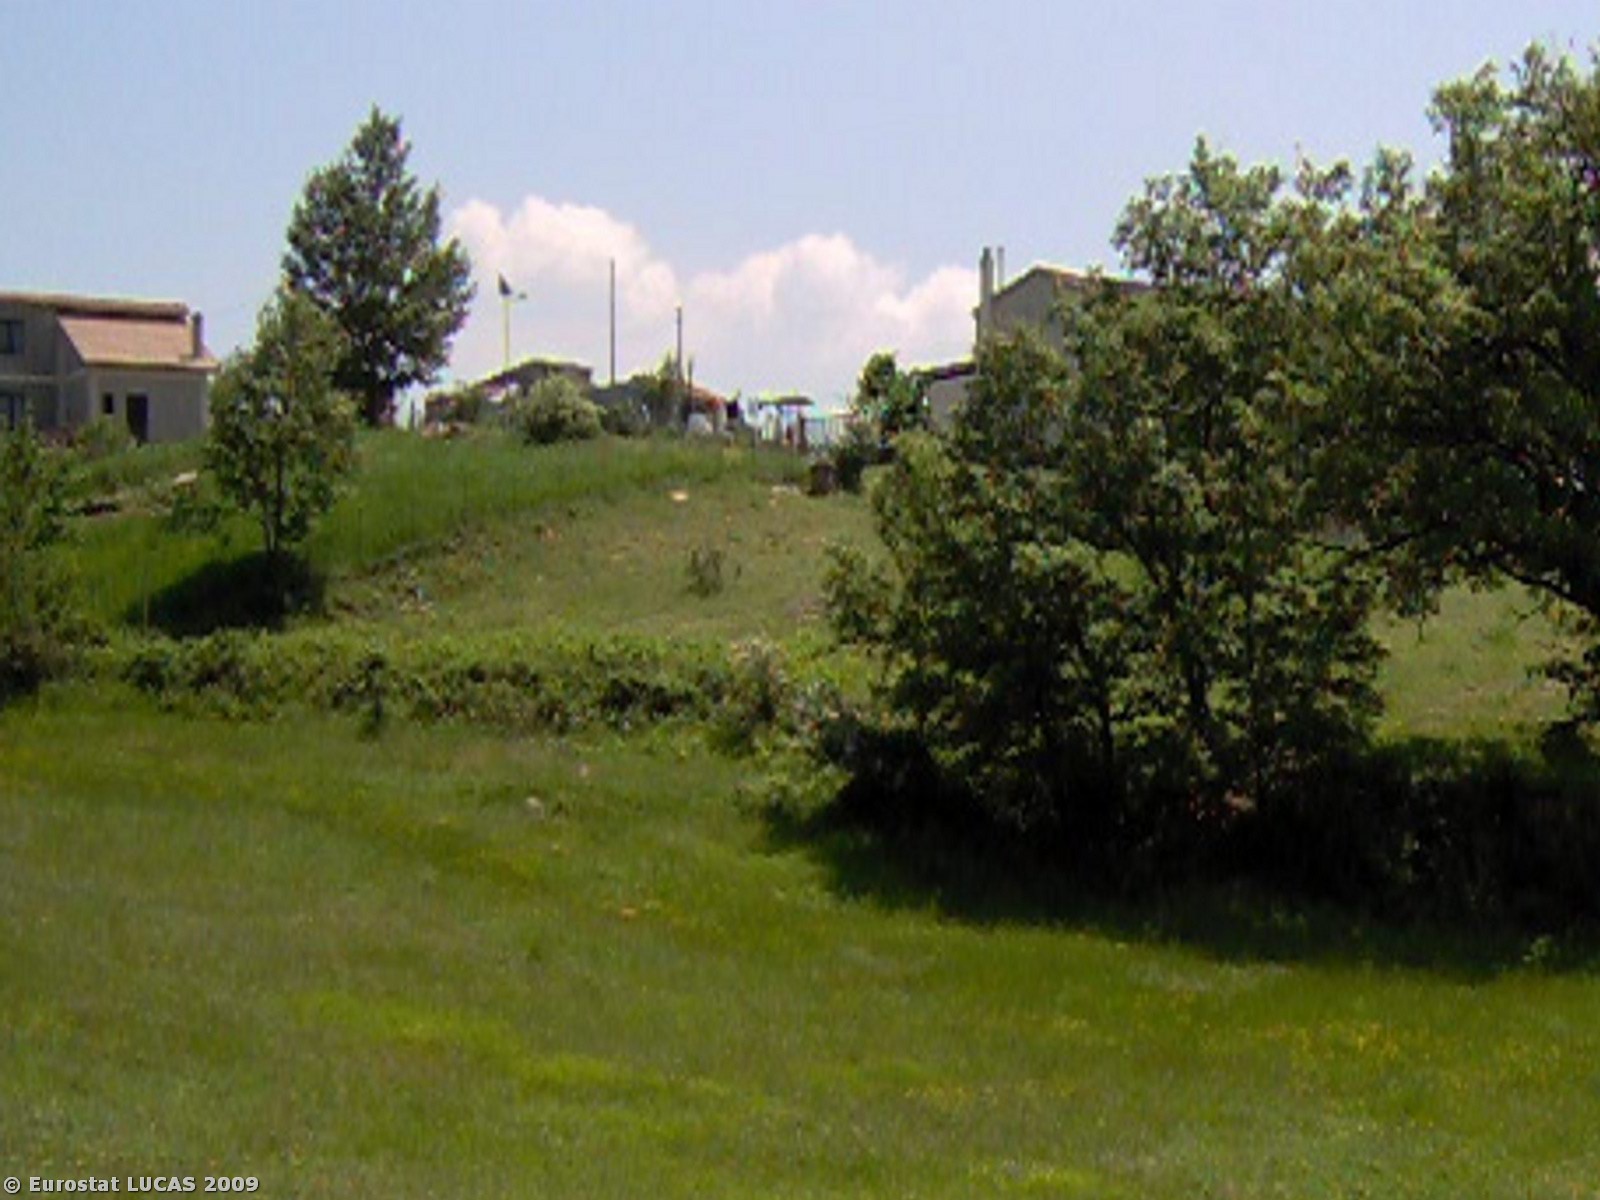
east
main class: Cropland
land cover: Mixed cereals for fodder
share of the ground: > 75 %
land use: Agriculture (excluding fallow land and kitchen gardens)
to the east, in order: Mixed cereals for fodder; Ditches and canals; Abandoned hedges; Fences; Barley; Fences; Grass margins; Paved roads, cycling and walking lanes; Grass margins; Fences; Artificial constructions in urban areas; Electric lines; Artificial constructions in urban areas; Spontaneously vegetated surfaces; Electric lines; Spontaneously vegetated surfaces; Fences; Mixed cereals for fodder; Barley
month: May
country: IT
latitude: 40.5808
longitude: 15.5658
